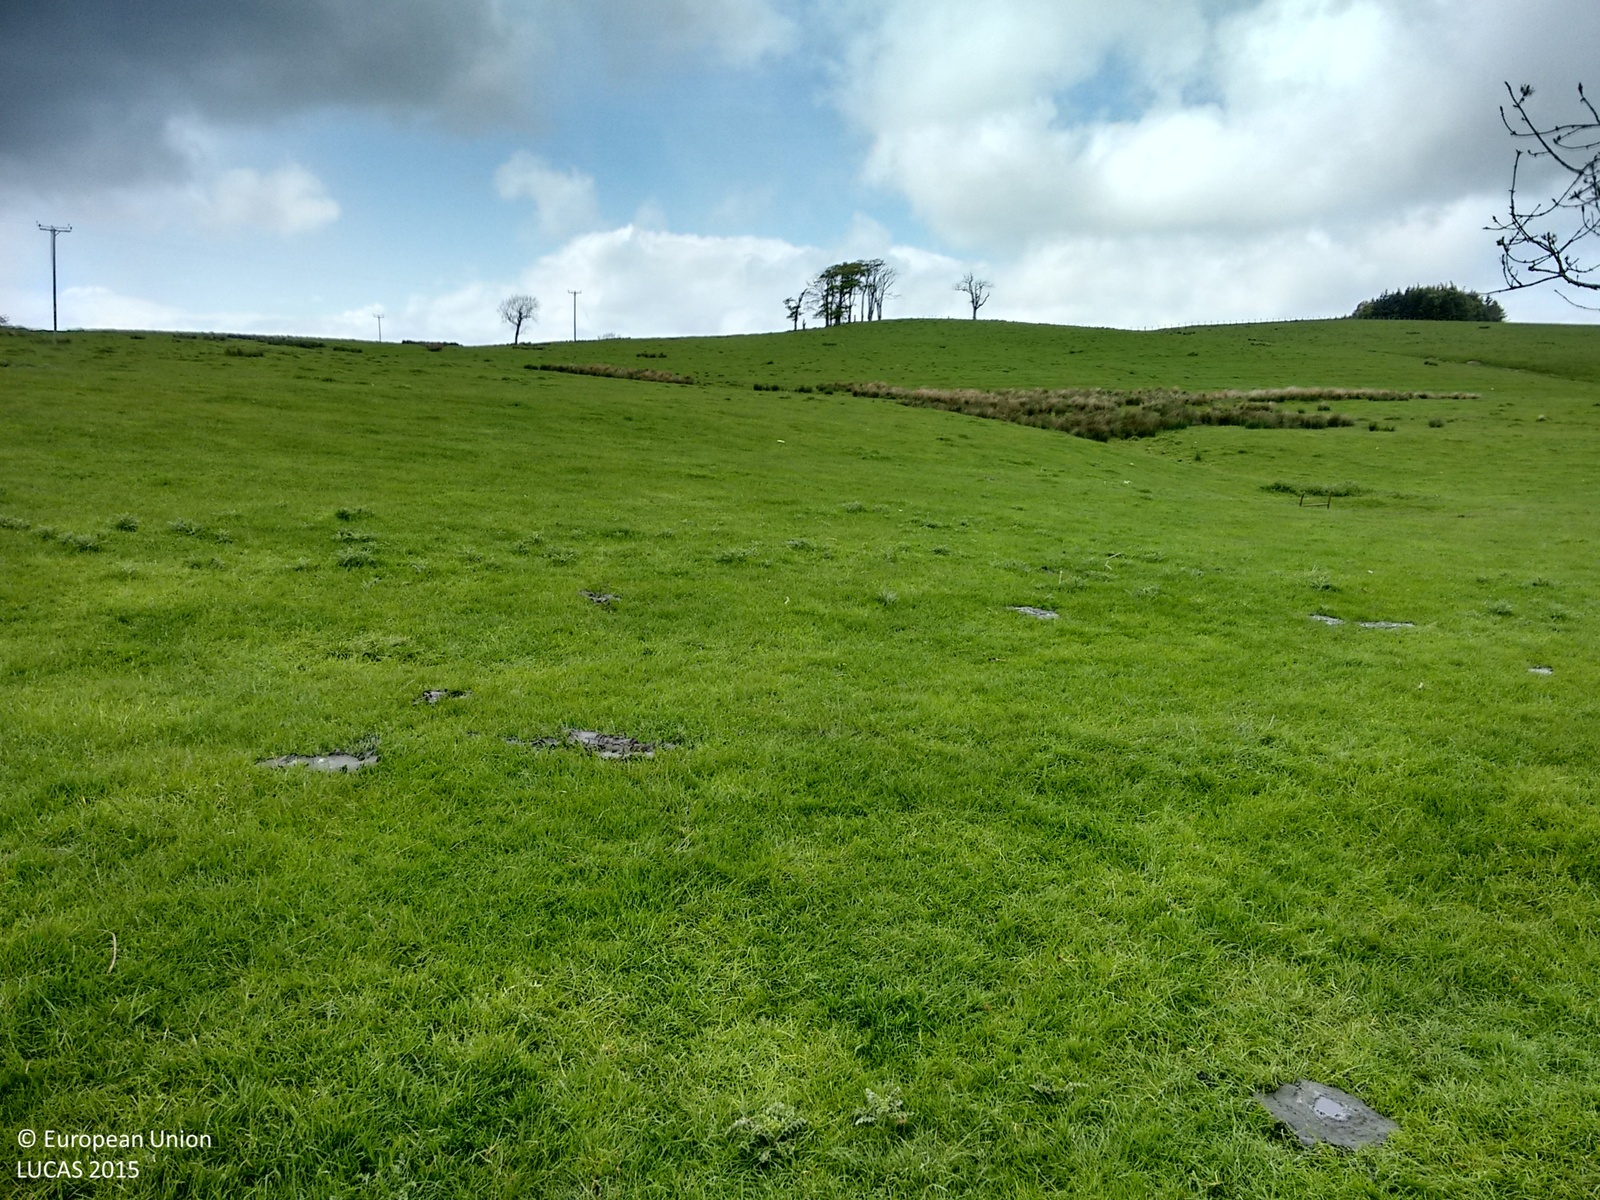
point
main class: Grassland
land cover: Grassland without tree/shrub cover
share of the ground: > 75 %
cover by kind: herbaceous plants 100 %
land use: Agriculture (excluding fallow land and kitchen gardens)
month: May
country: GB
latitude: 55.1168
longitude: -2.1447
